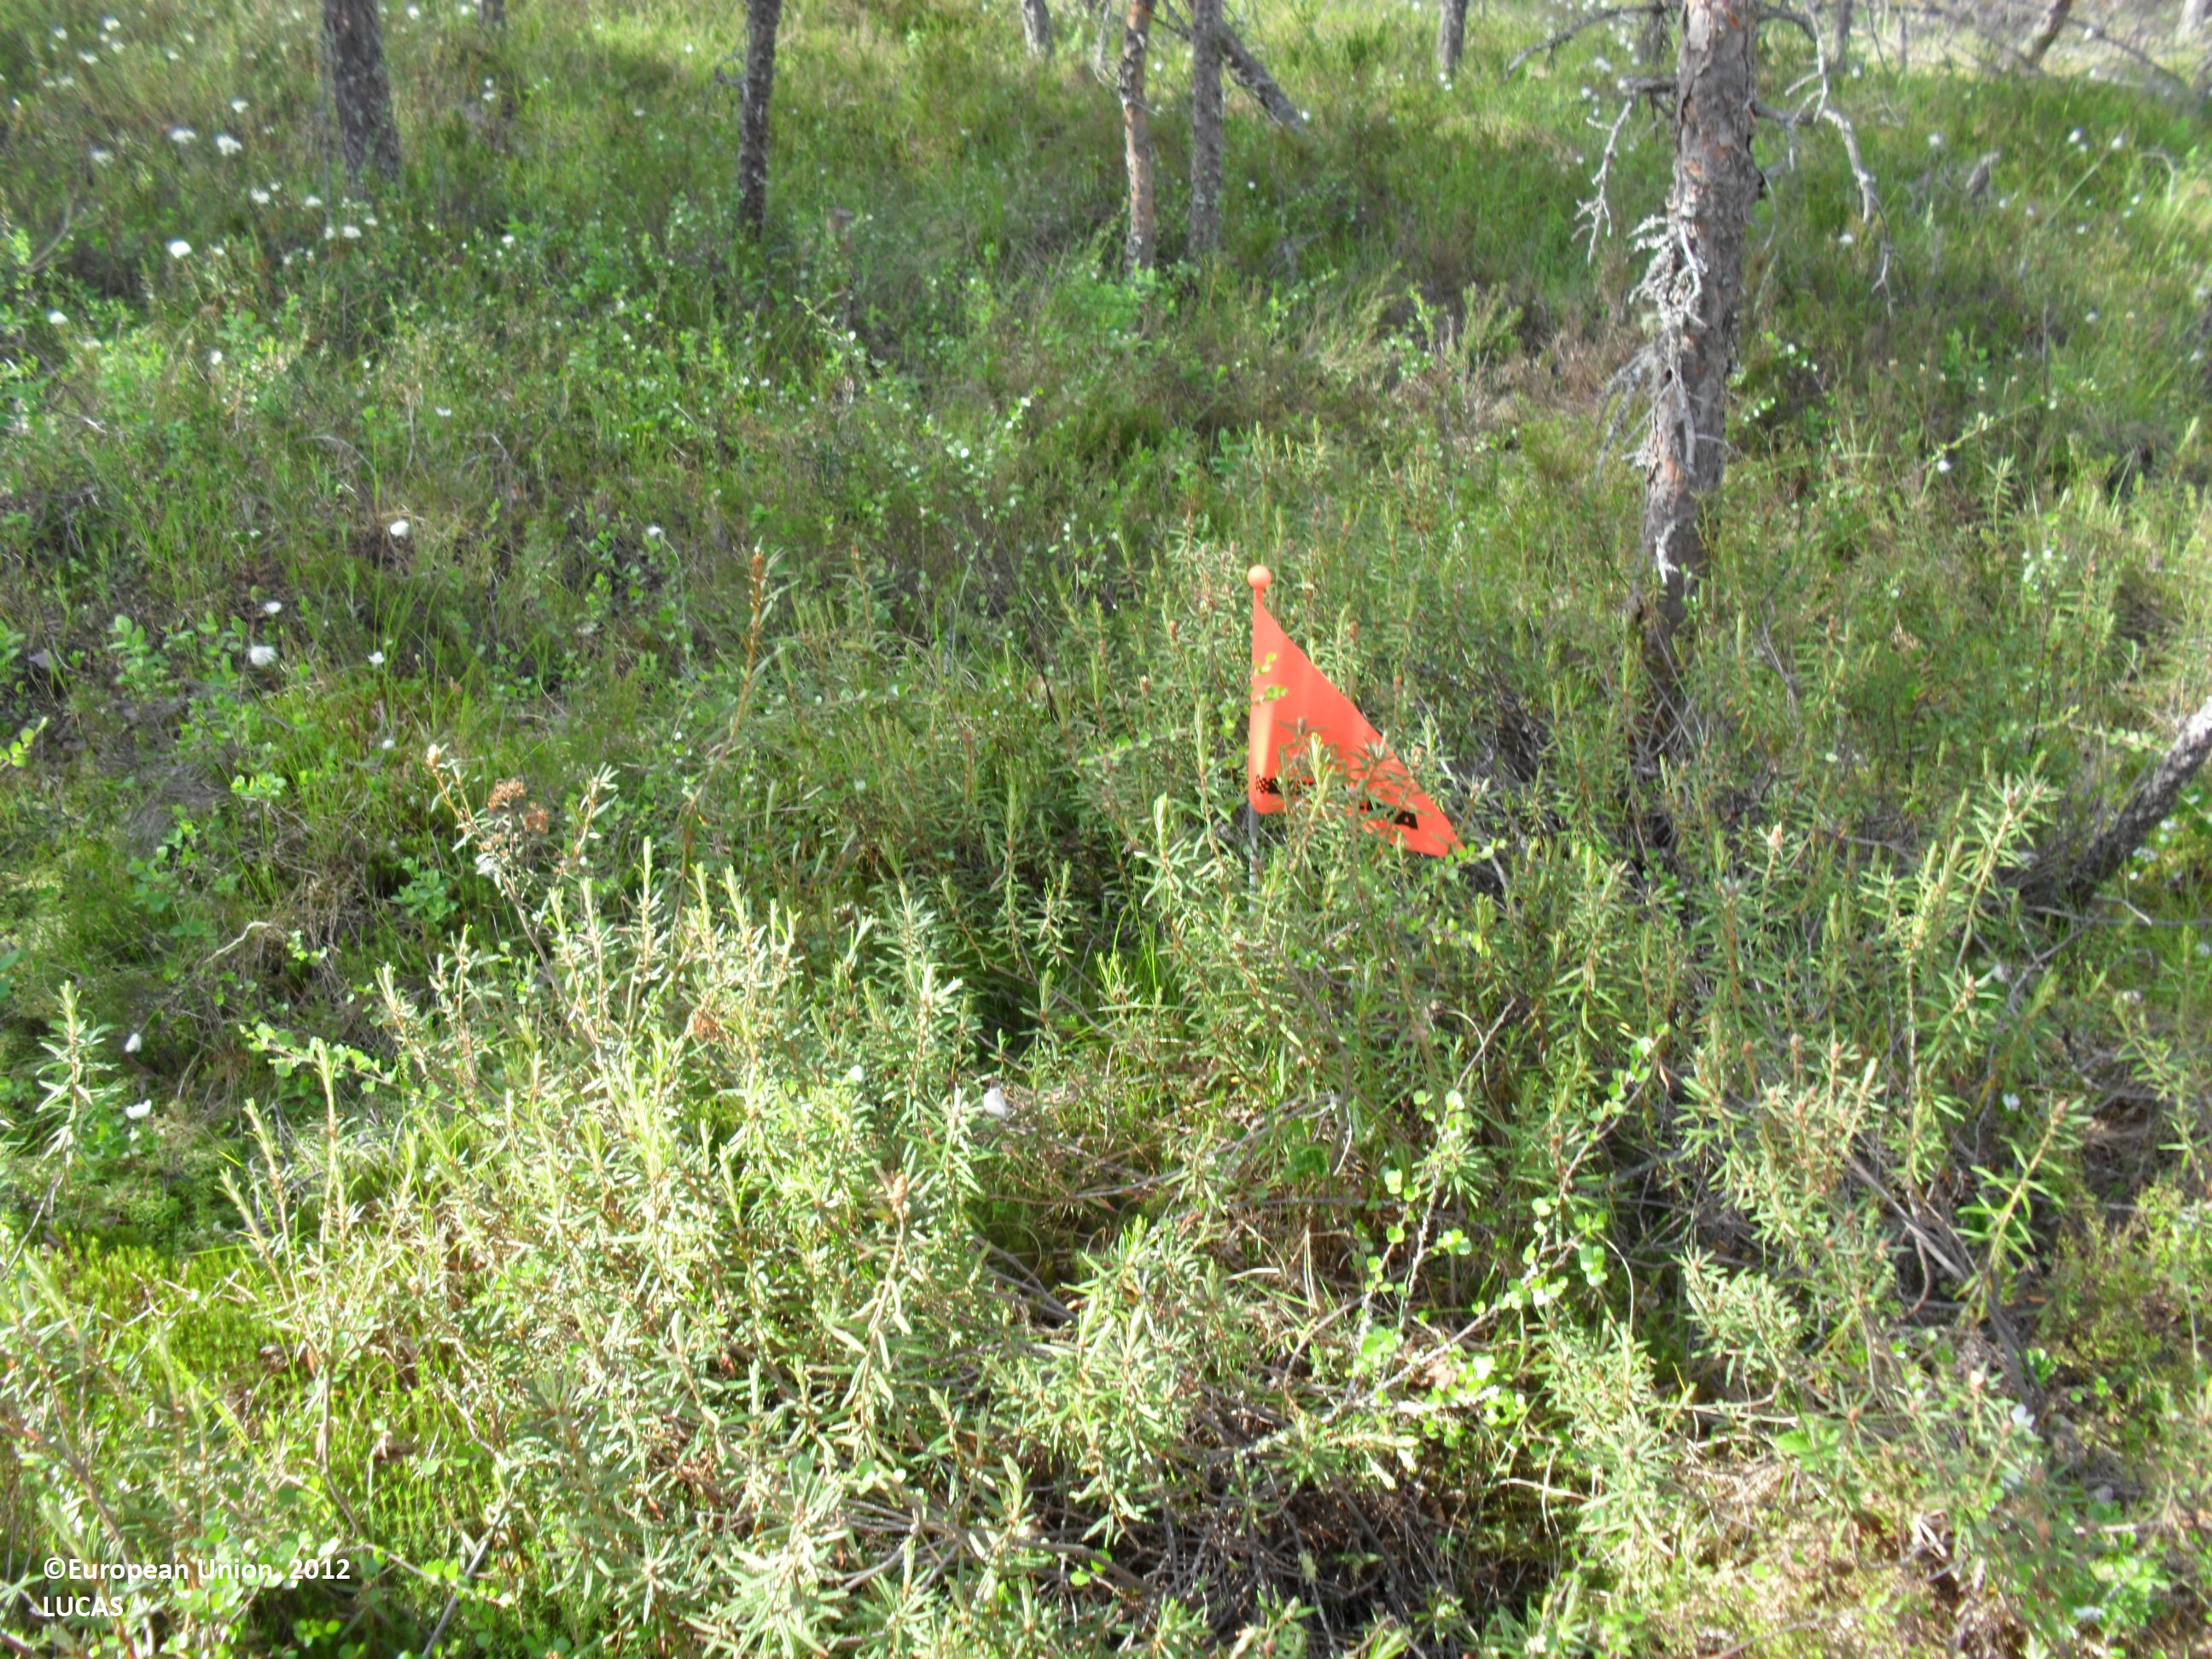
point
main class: Woodland
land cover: Pine dominated coniferous woodland
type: mire and swamp forests
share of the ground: 25 - 50 %
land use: Forestry
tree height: > 5 m
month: June
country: FI
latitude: 62.9237
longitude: 23.4374
